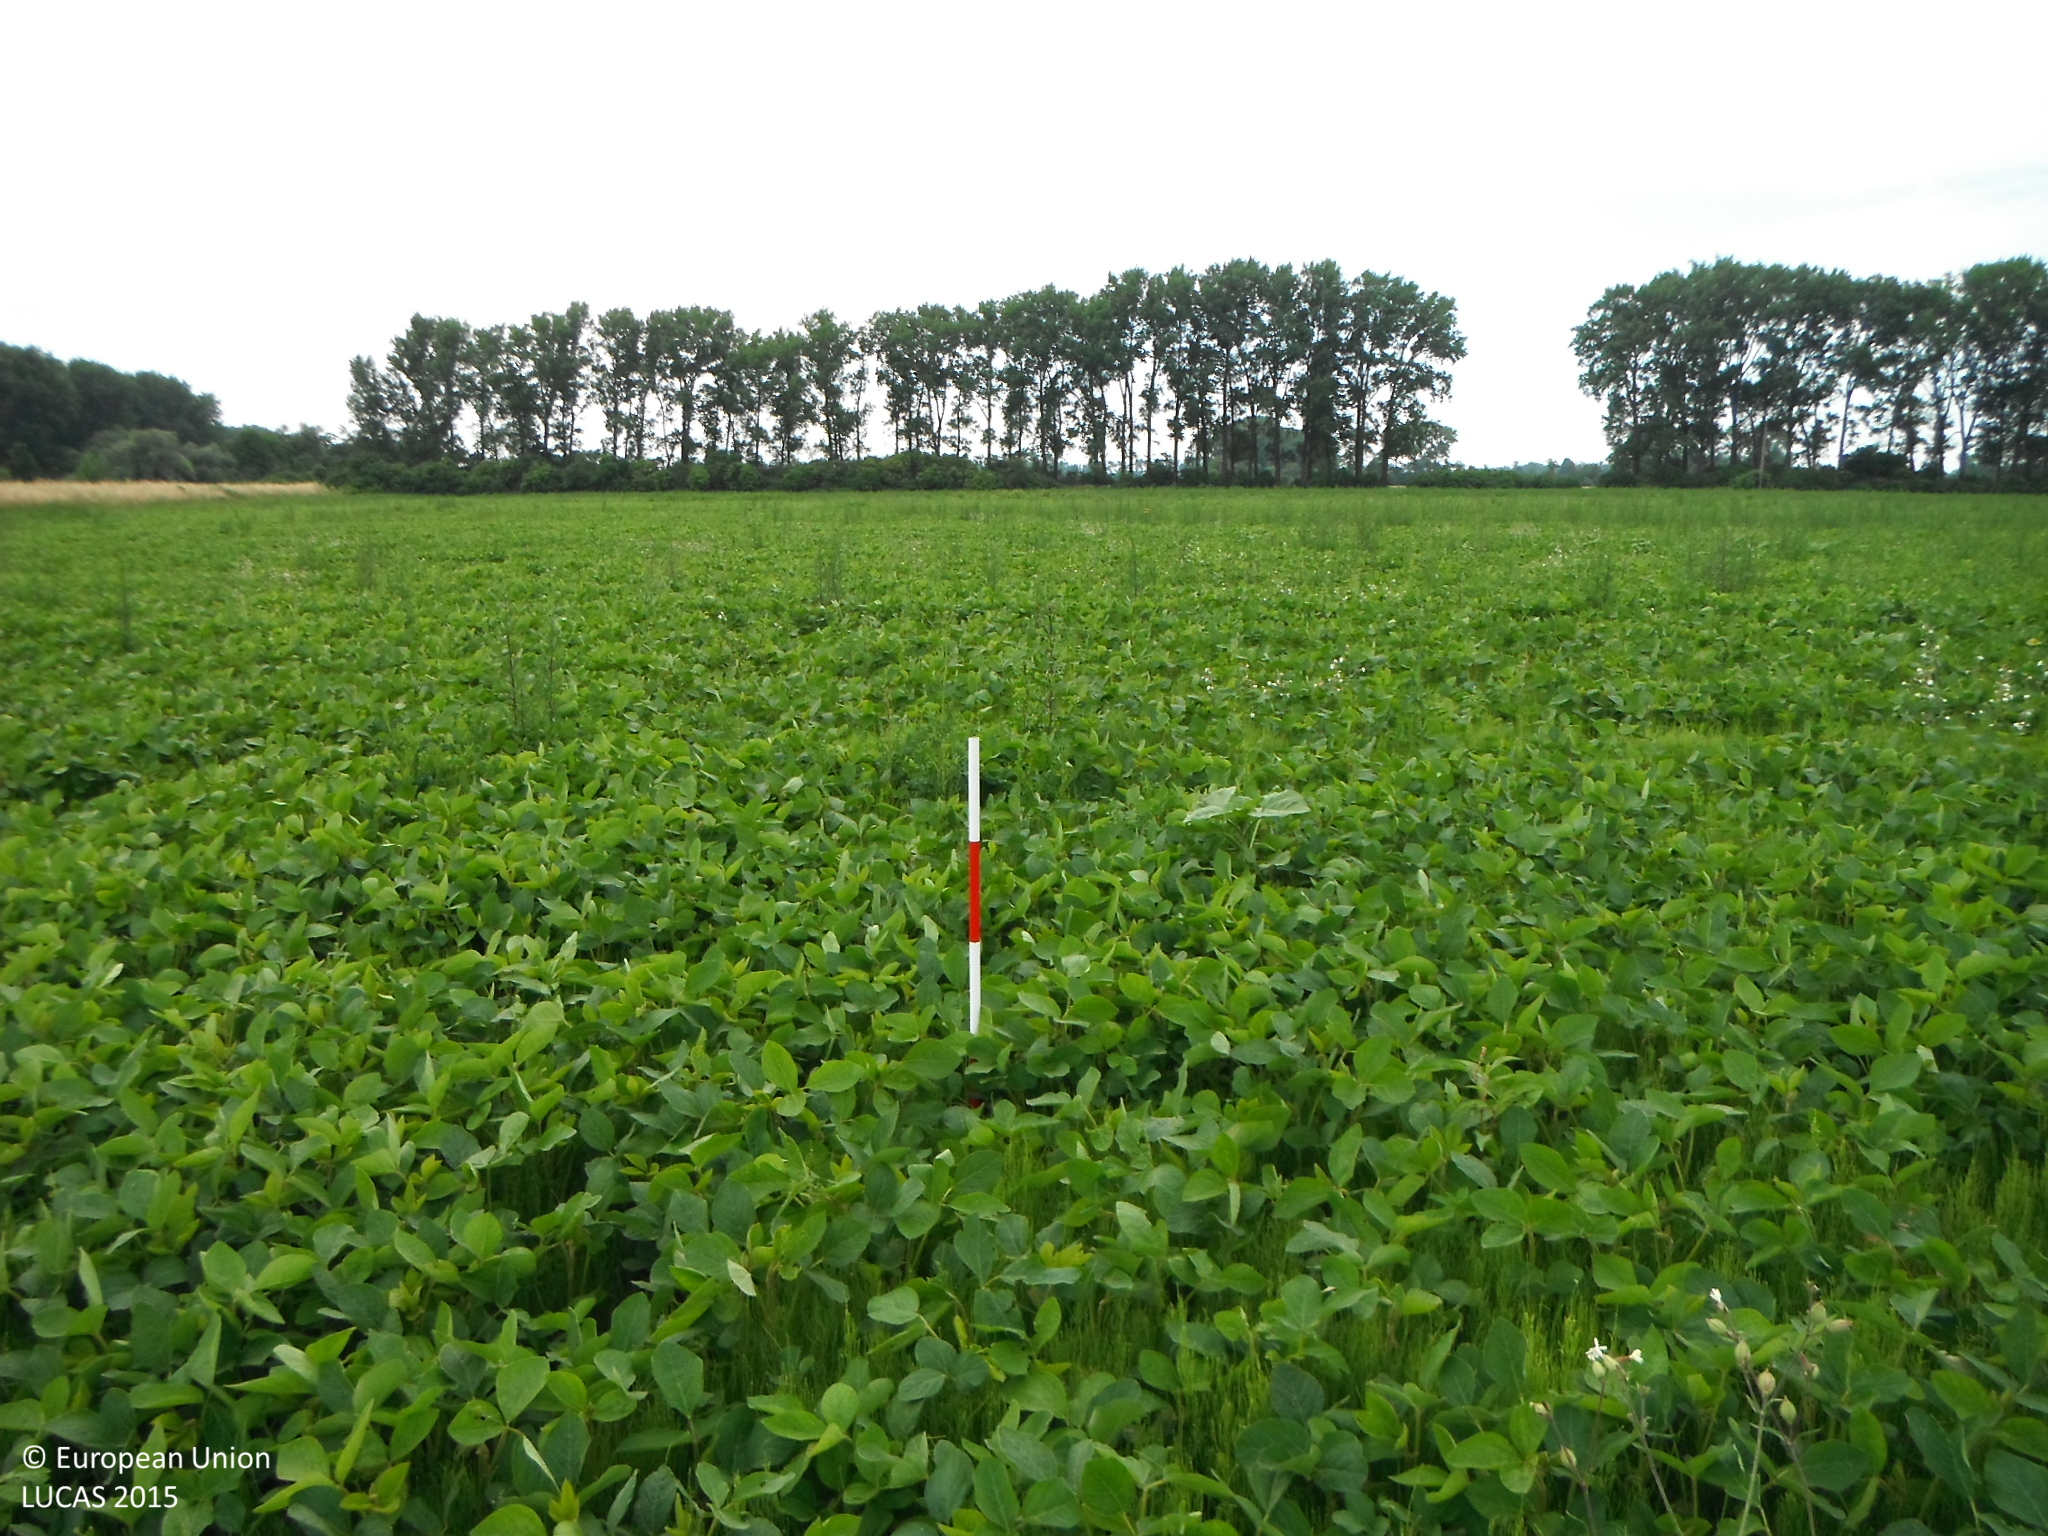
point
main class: Cropland
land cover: Soya
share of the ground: > 75 %
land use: Agriculture (excluding fallow land and kitchen gardens)
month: June
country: SK
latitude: 48.7578
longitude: 21.7359
